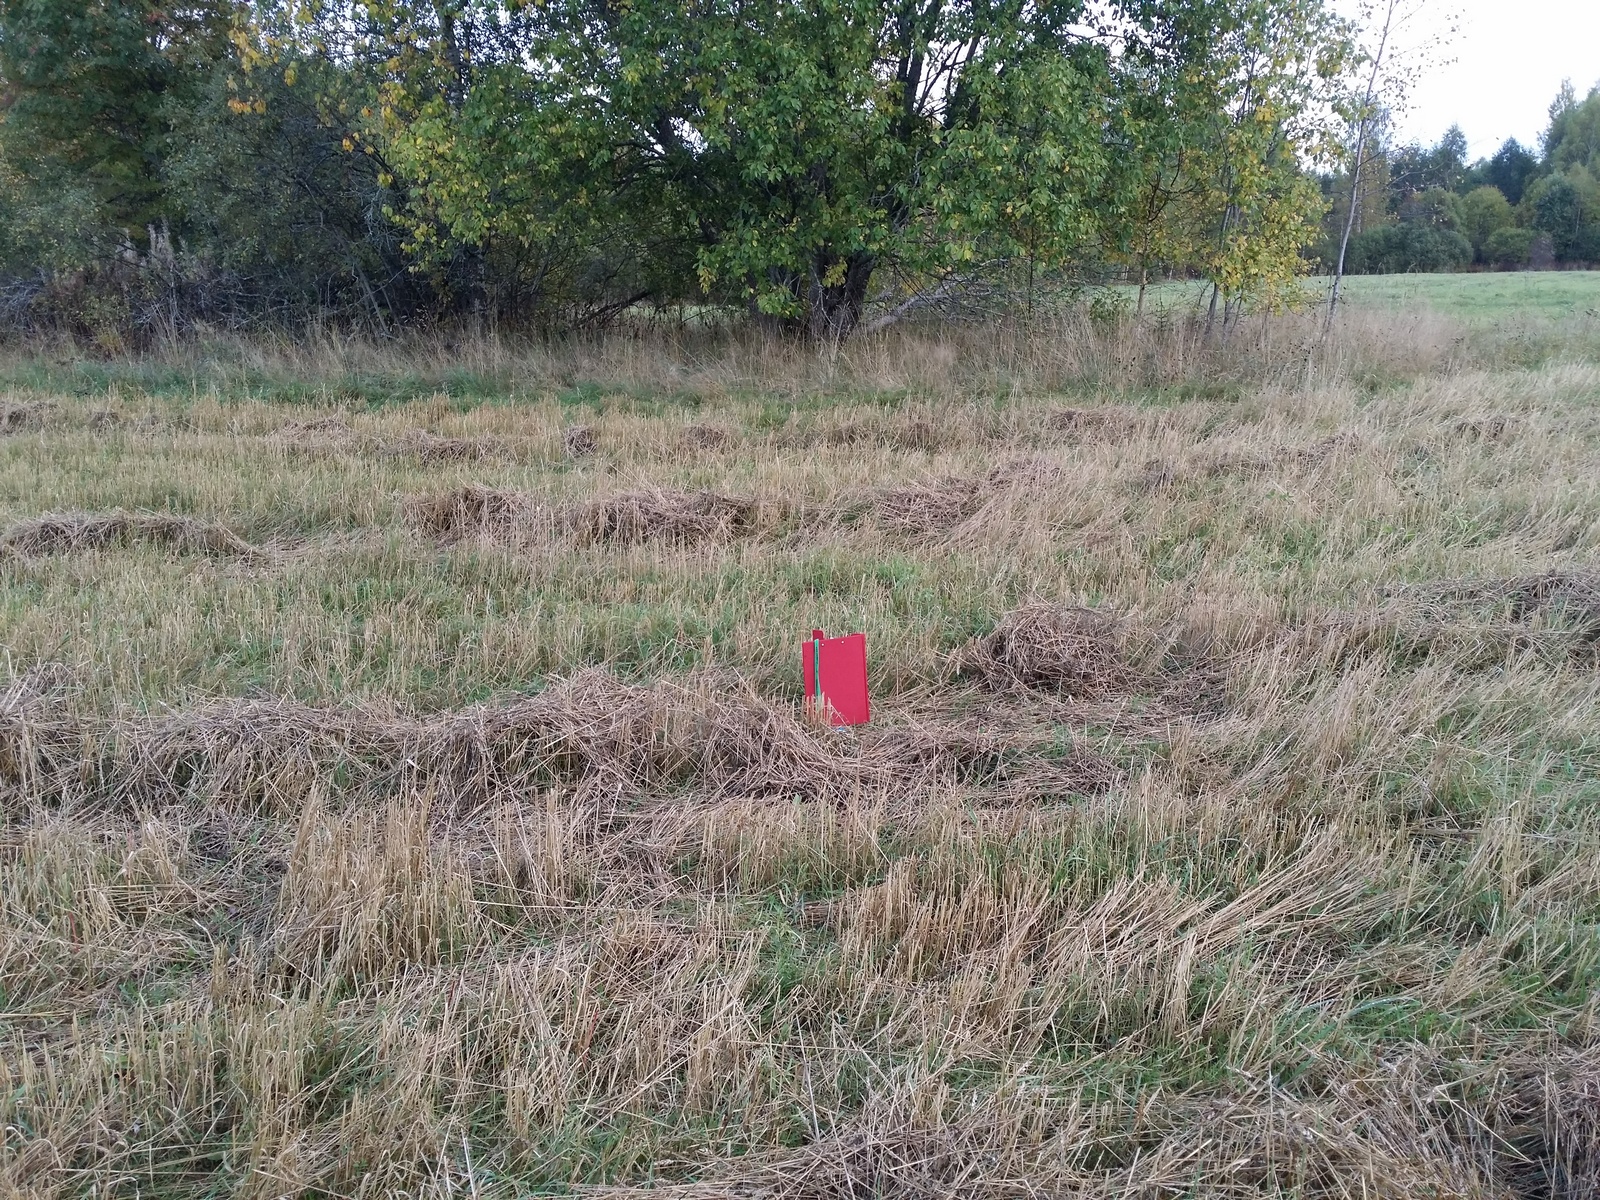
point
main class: Cropland
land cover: Common wheat
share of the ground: 50 - 75 %
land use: Agriculture (excluding fallow land and kitchen gardens)
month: September
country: LV
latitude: 57.5074
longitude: 27.4469
